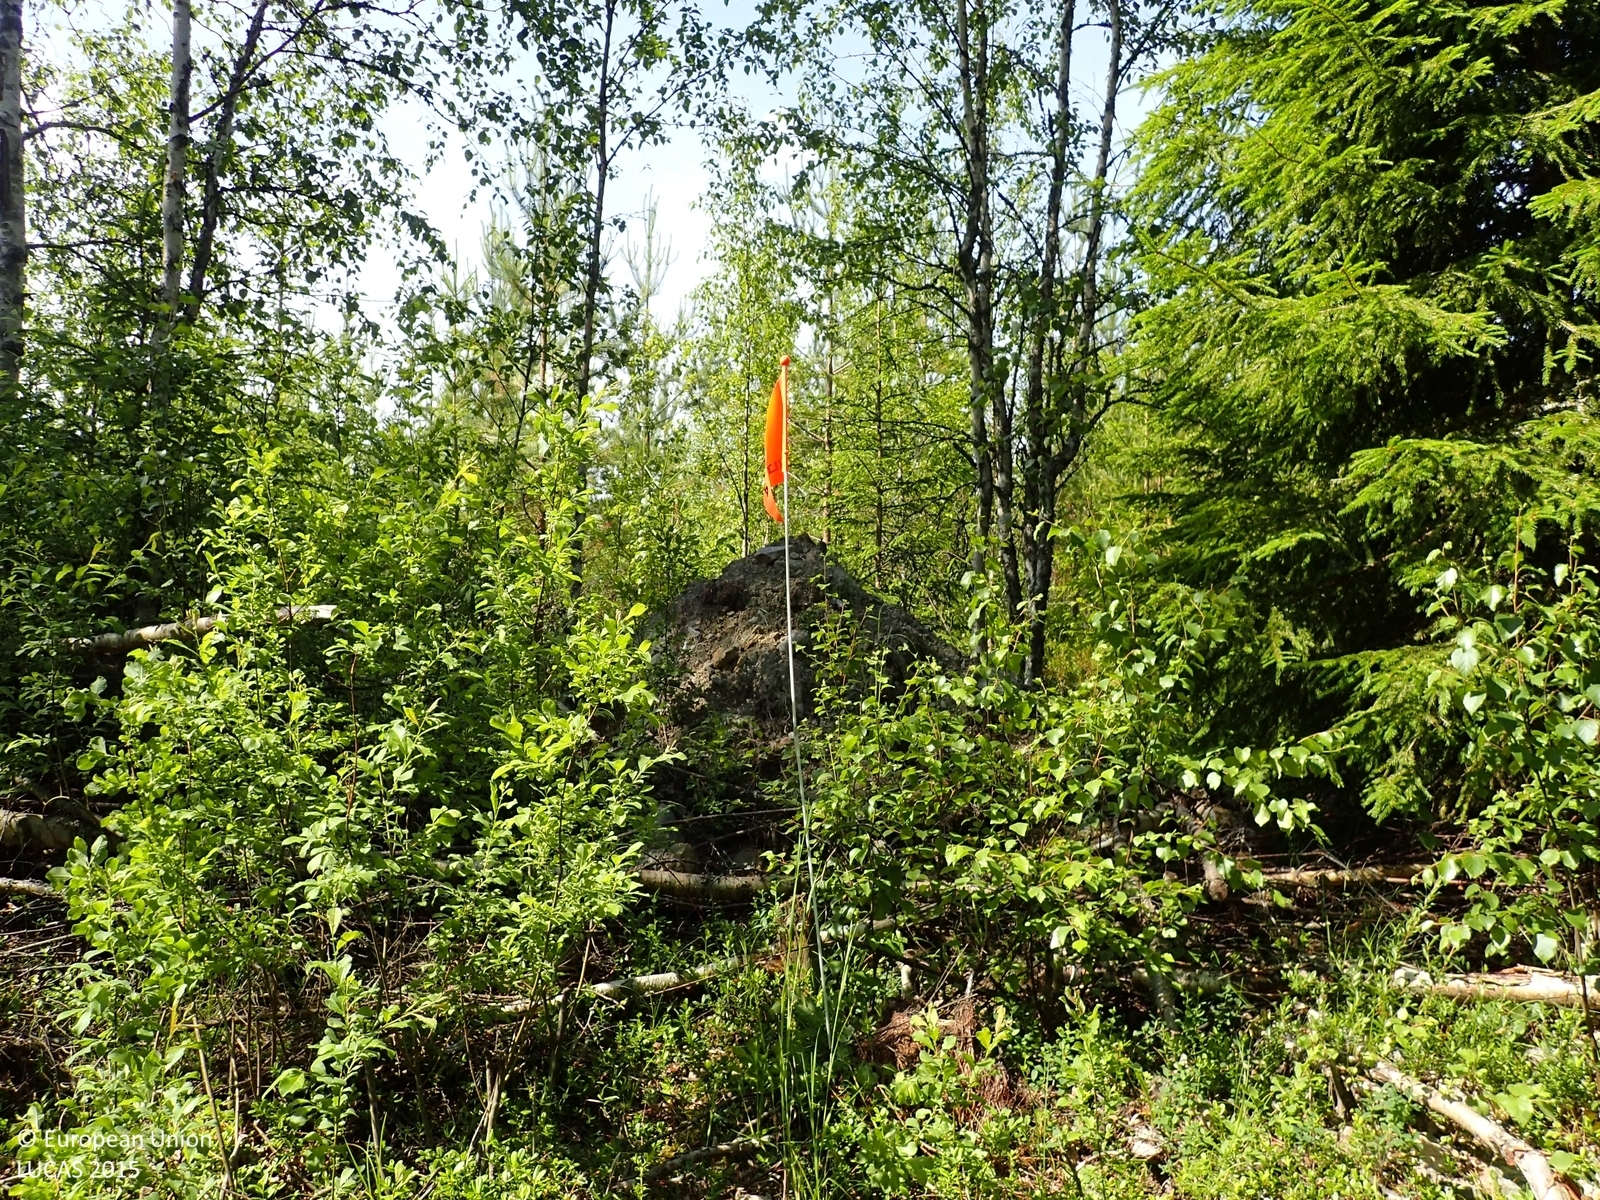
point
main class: Woodland
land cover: Spruce dominated mixed woodland
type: boreal forest
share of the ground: > 75 %
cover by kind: coniferous forest trees 45 %, broadleaved forest trees 40 %, shrubs 10 %, herbaceous plants 5 %
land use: Forestry
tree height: > 5 m
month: July
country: FI
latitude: 62.7726
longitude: 21.5023
